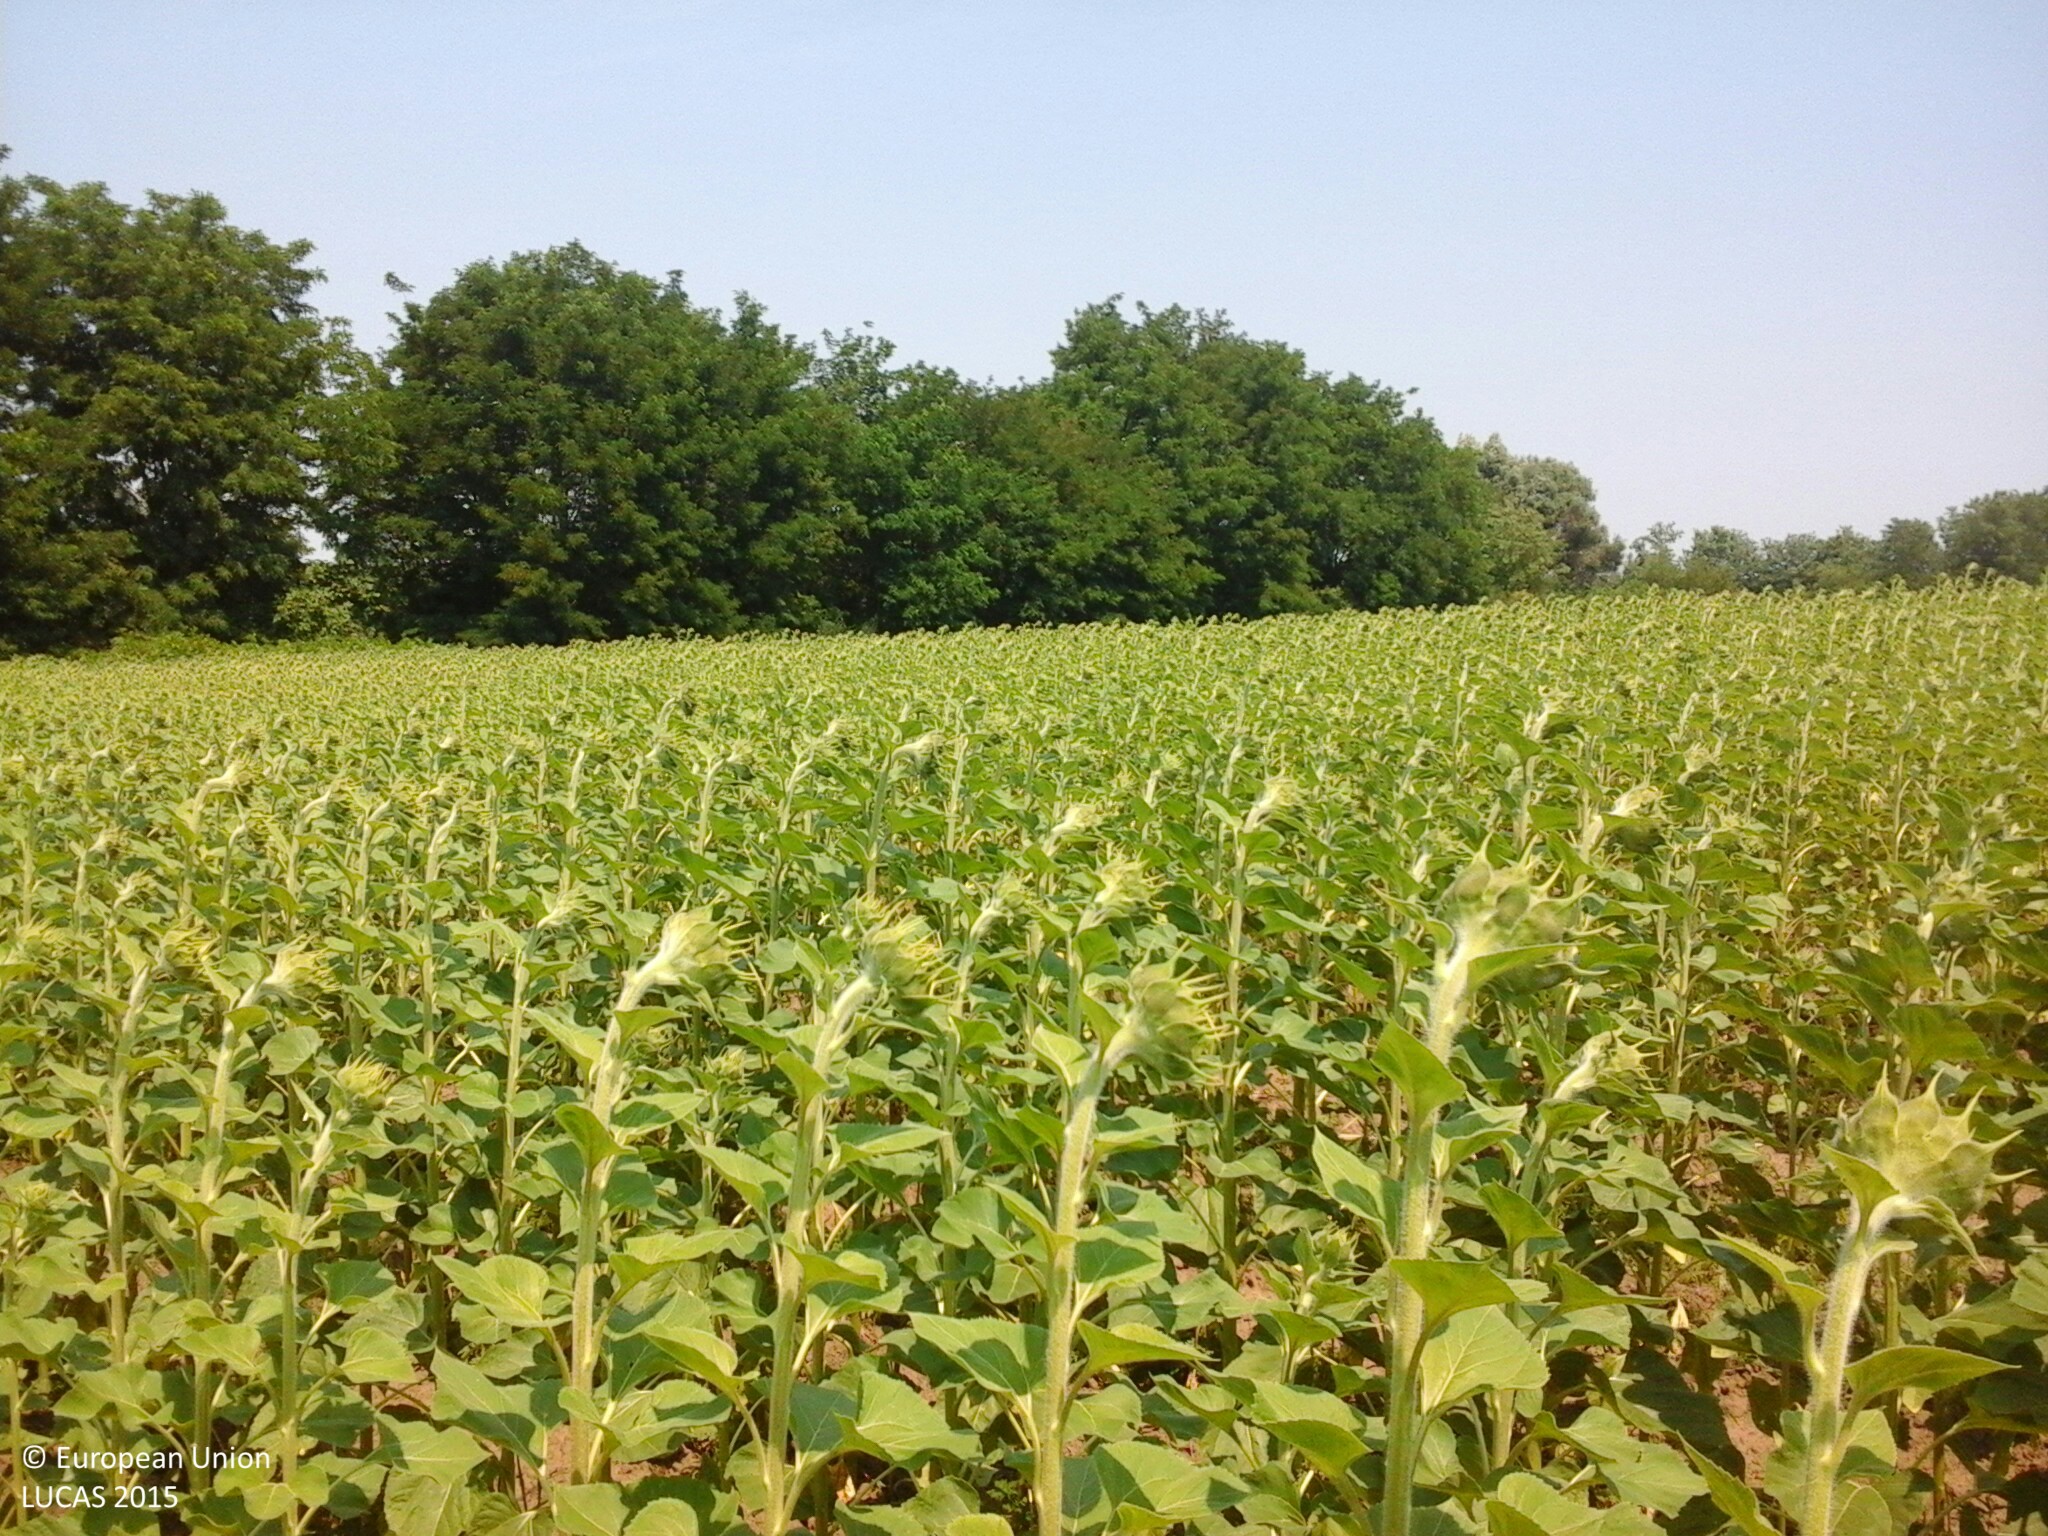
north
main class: Cropland
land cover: Sunflower
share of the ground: 50 - 75 %
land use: Agriculture (excluding fallow land and kitchen gardens)
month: July
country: HU
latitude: 48.0410
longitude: 22.1395
